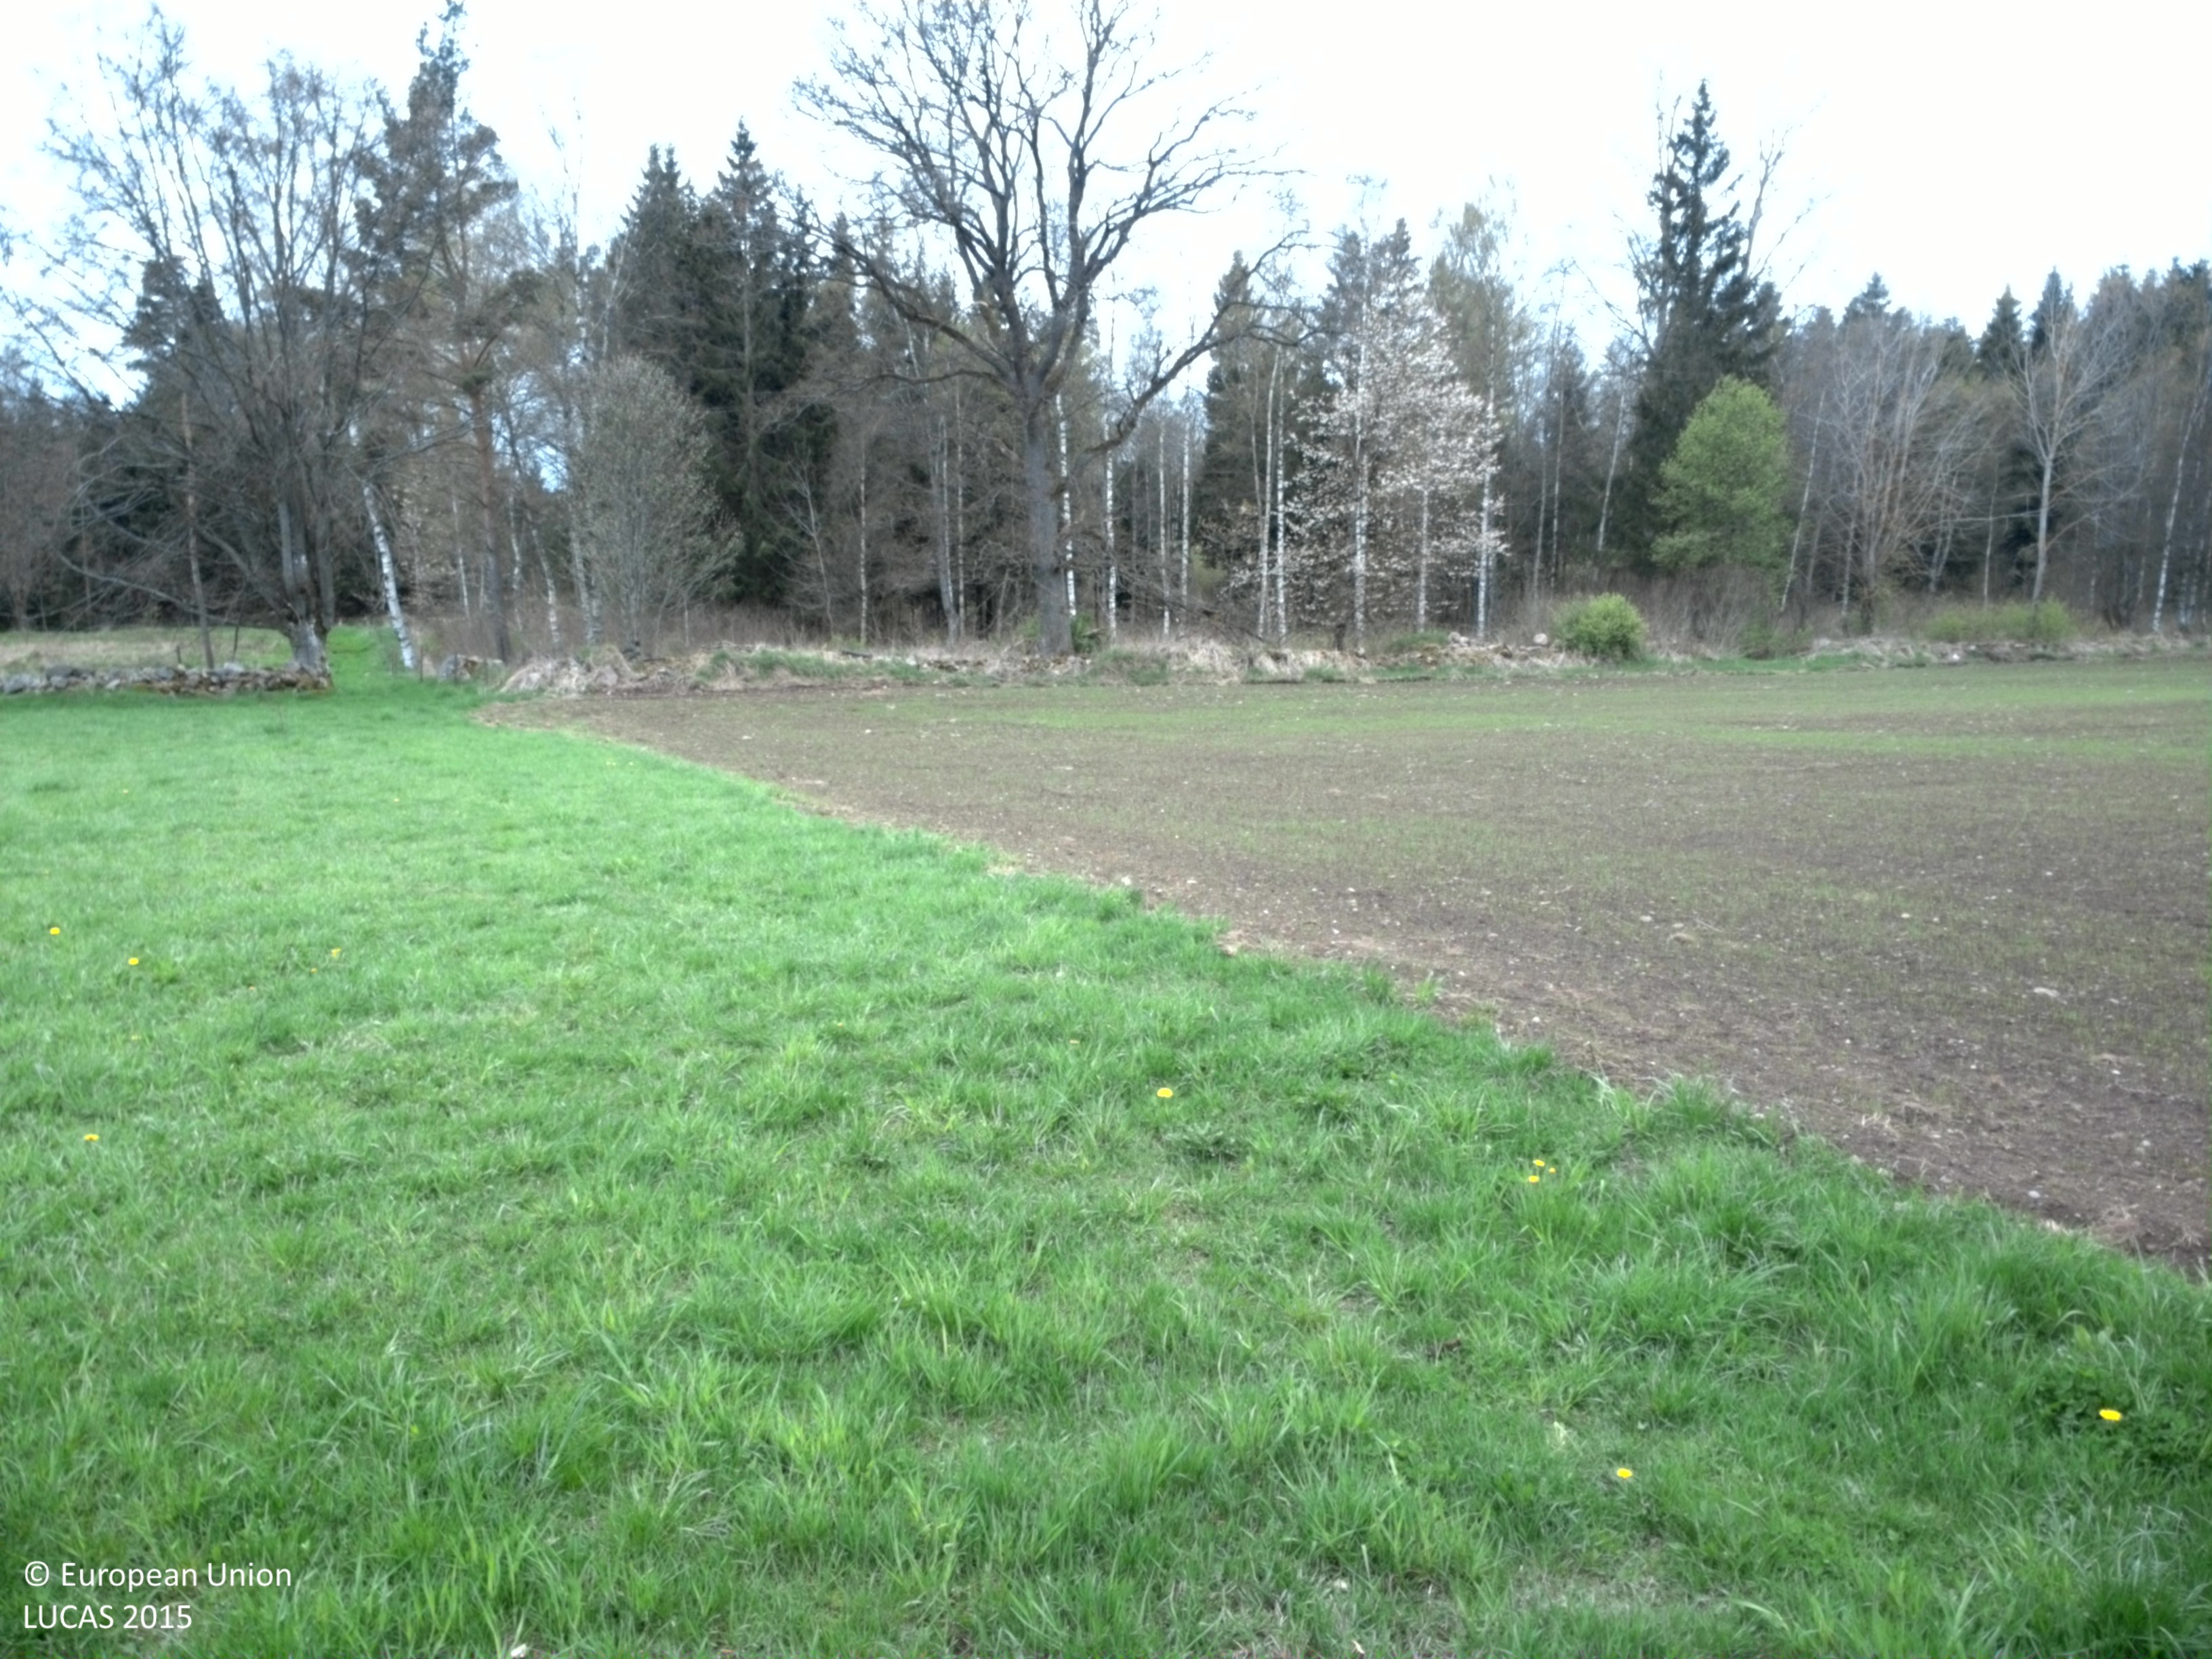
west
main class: Grassland
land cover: Grassland without tree/shrub cover
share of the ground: > 75 %
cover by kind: herbaceous plants 100 %
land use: Agriculture (excluding fallow land and kitchen gardens)
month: May
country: SE
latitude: 56.8210
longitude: 14.7322
